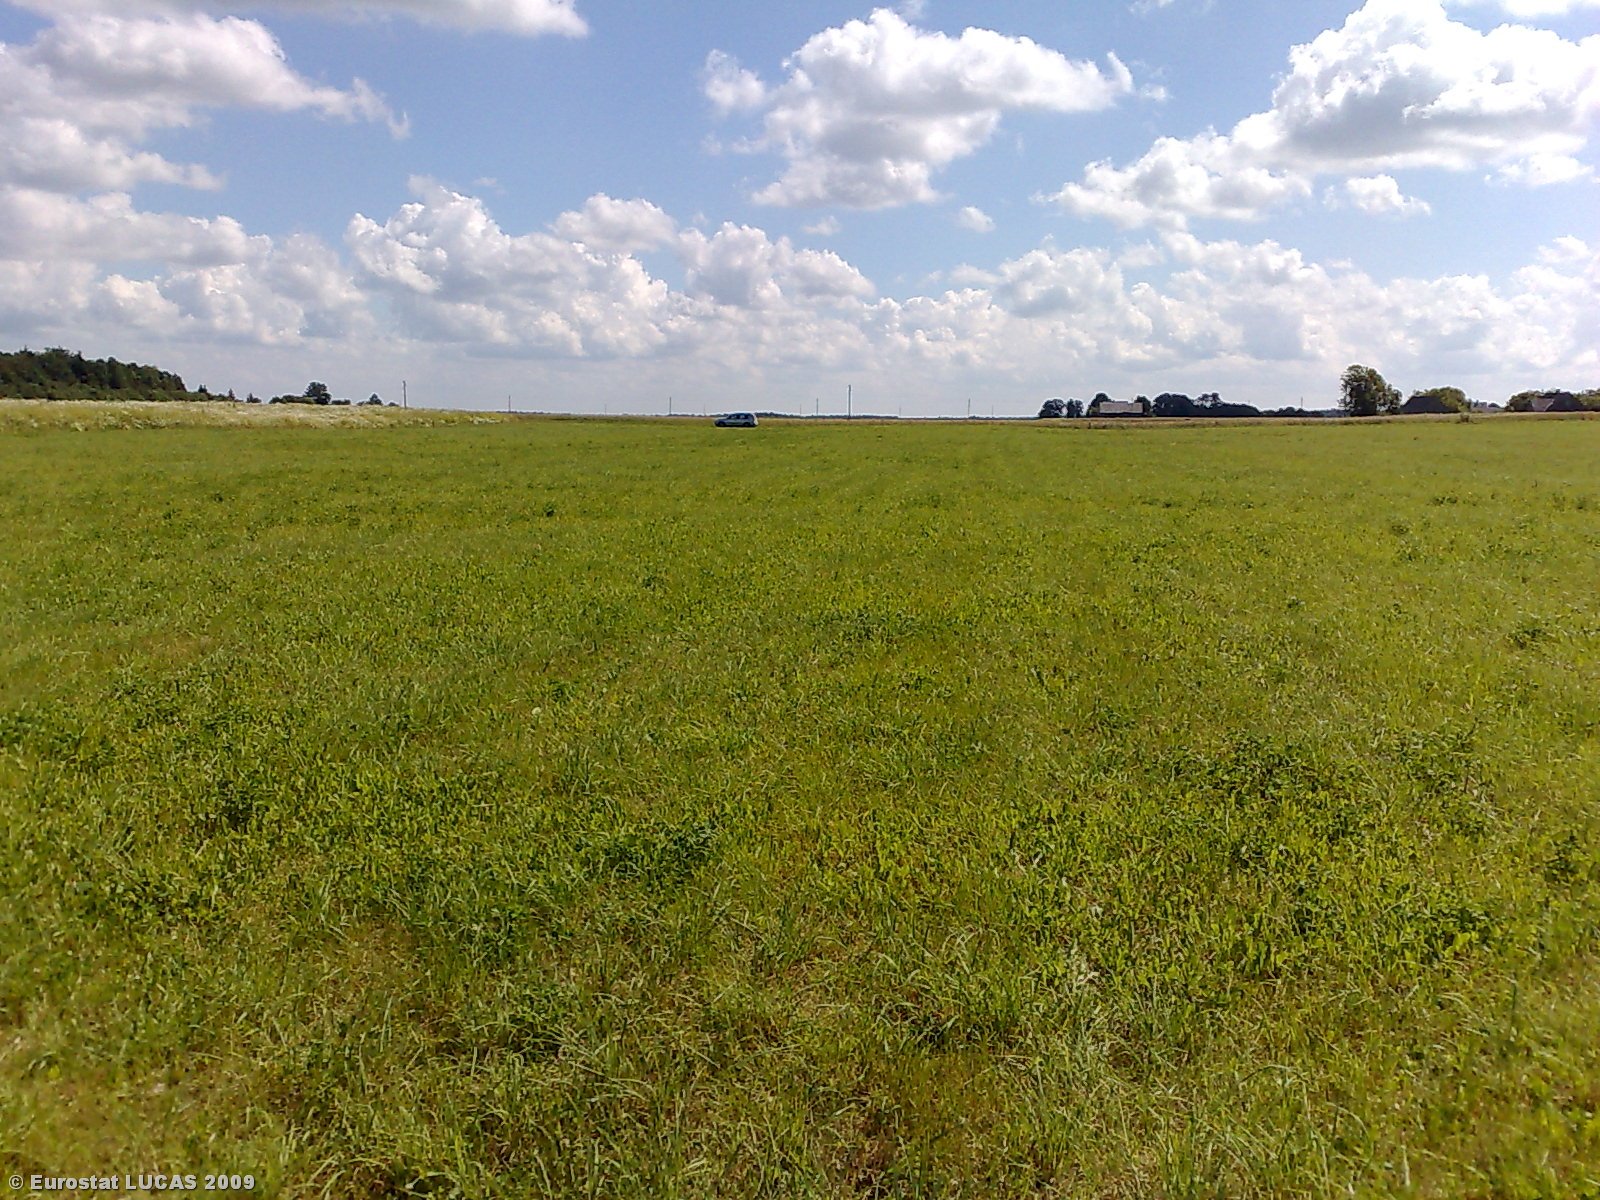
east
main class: Grassland
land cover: Grassland without tree/shrub cover
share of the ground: > 75 %
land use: Agriculture (excluding fallow land and kitchen gardens)
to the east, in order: Grassland without tree/shrub cover; Tracks; Rye
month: July
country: LT
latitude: 55.9354
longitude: 22.8885
